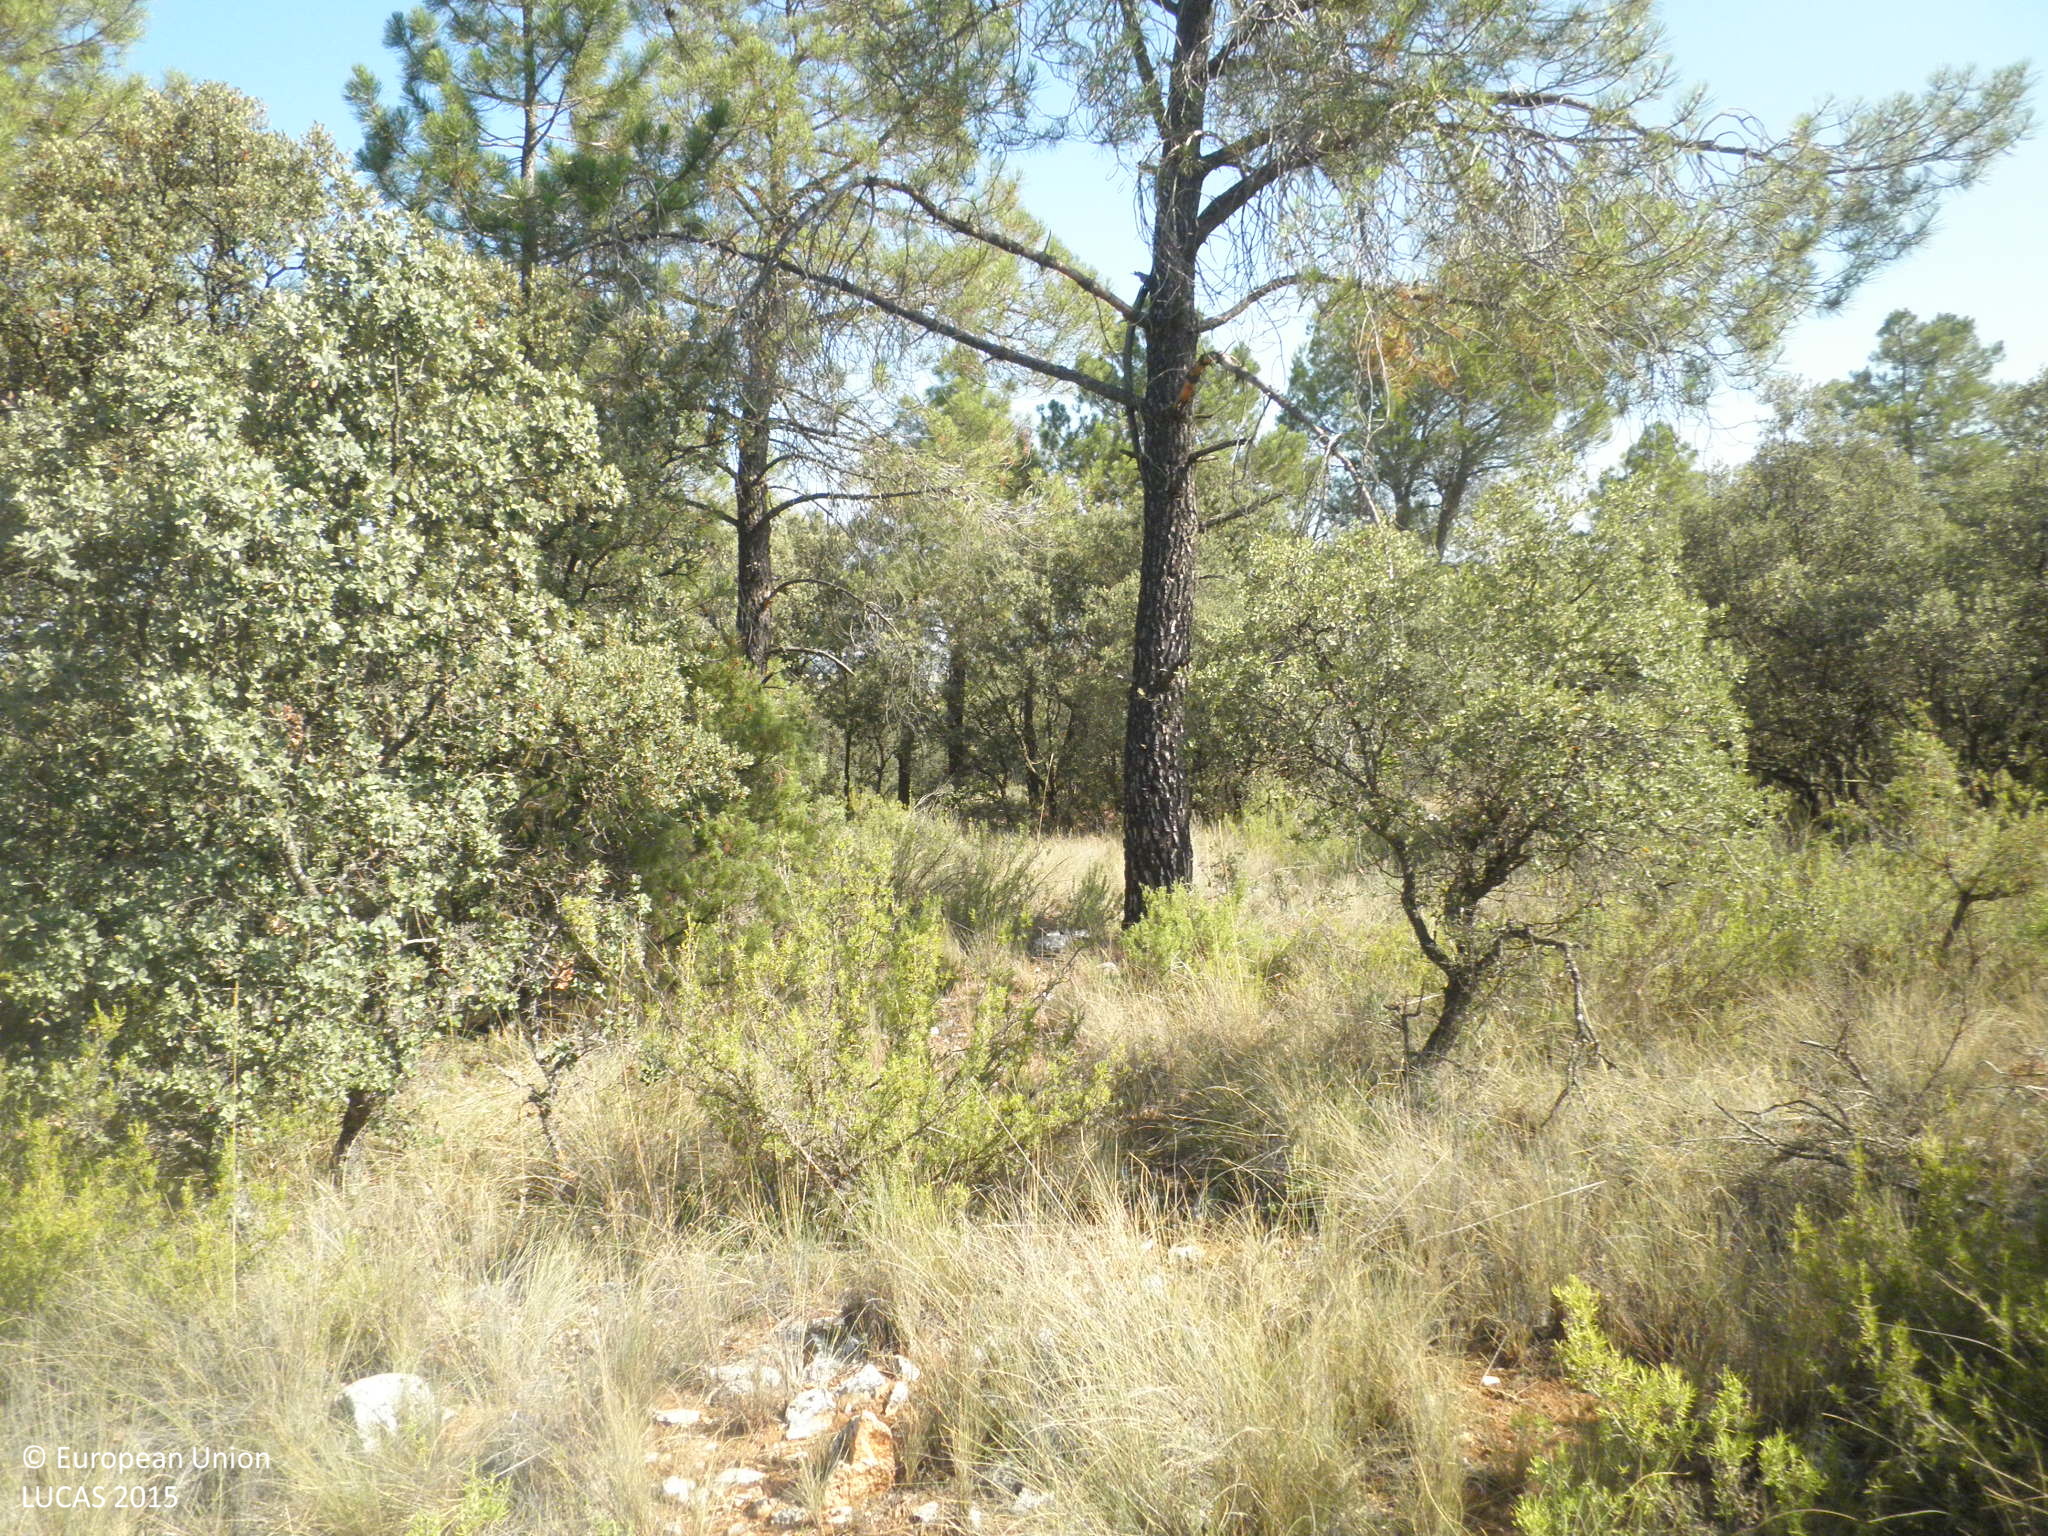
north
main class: Woodland
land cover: Pine dominated mixed woodland
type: coniferous forest of the mediterranean region
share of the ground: 25 - 50 %
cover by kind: coniferous forest trees 25 %, unconsolidated bare surface 25 %, broadleaved forest trees 20 %, shrubs 15 %, herbaceous plants 15 %
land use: Semi-natural and natural areas not in use
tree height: > 5 m
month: July
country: ES
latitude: 39.6302
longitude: -1.7630
